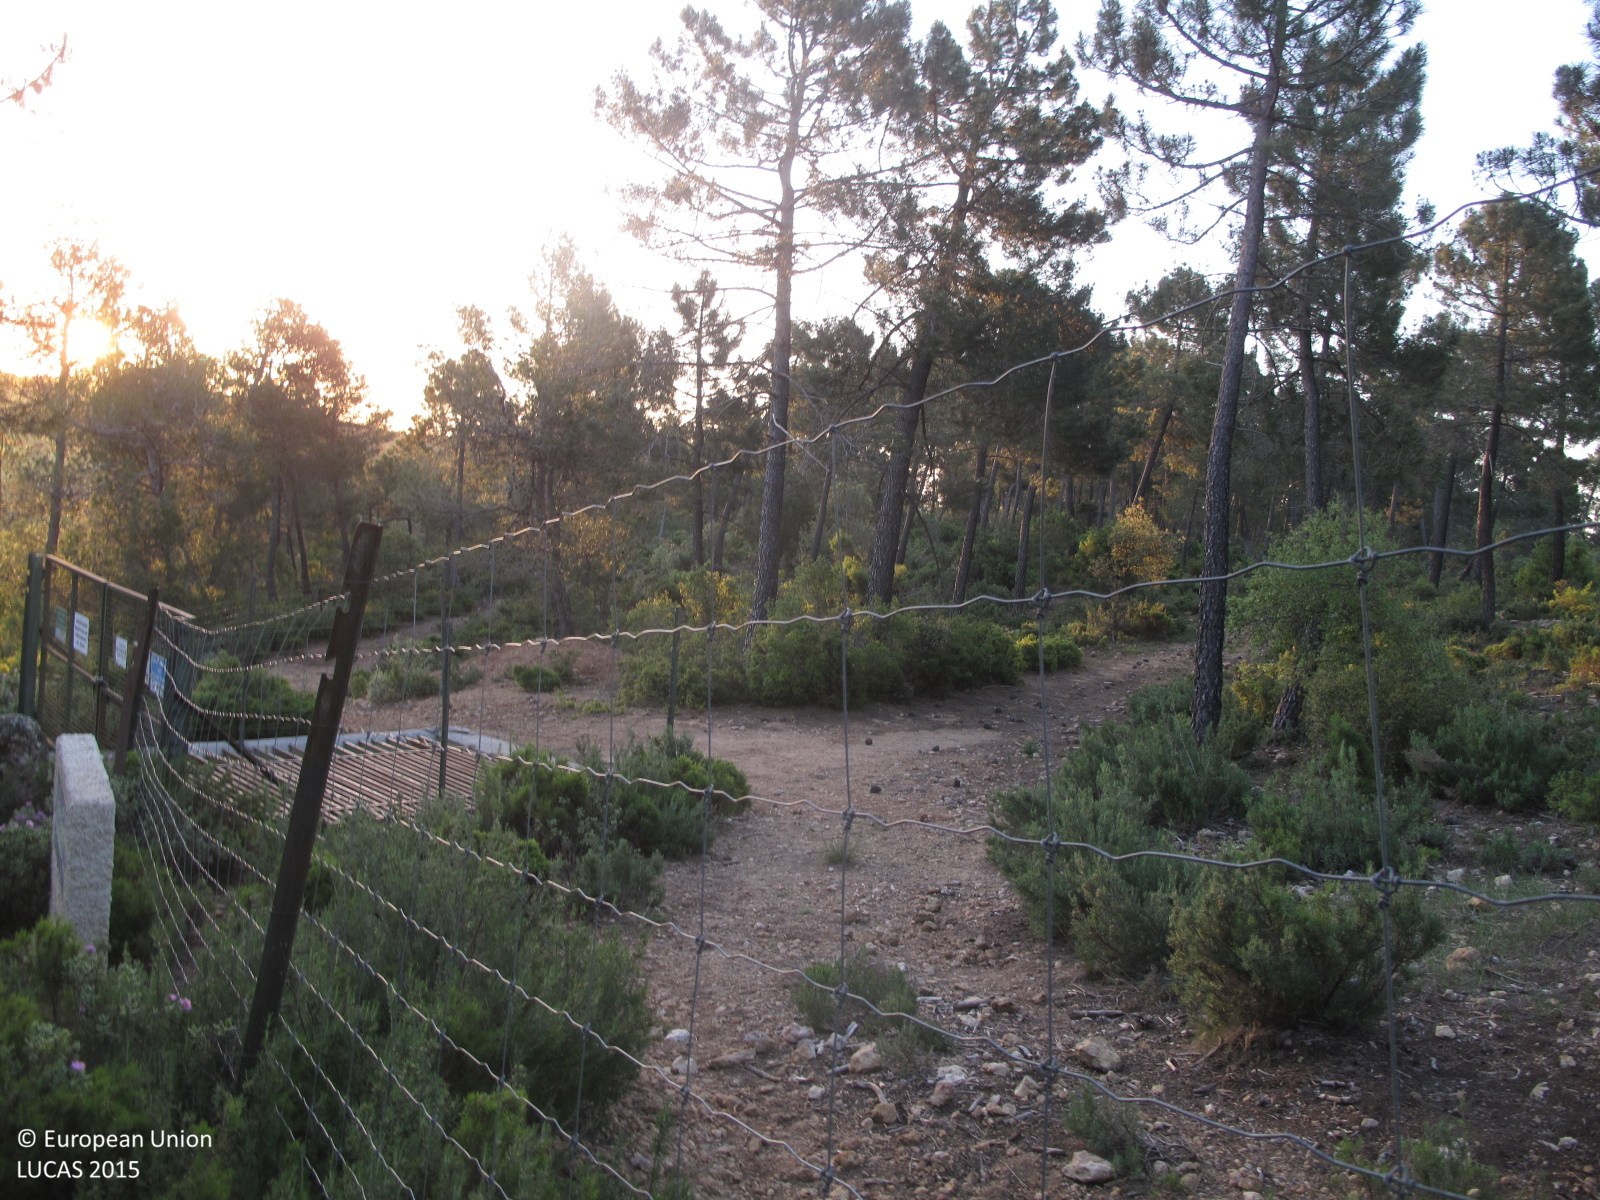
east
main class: Shrubland
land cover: Shrubland with sparse tree cover
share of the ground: 50 - 75 %
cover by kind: shrubs 50 %, herbaceous plants 30 %, consolidated bare surface 15 %, coniferous forest trees 5 %
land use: Semi-natural and natural areas not in use
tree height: > 5 m
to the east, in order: Shrubland with sparse tree cover; Pine dominated coniferous woodland; Other bare soil
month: May
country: ES
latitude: 38.9542
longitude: -0.9915
